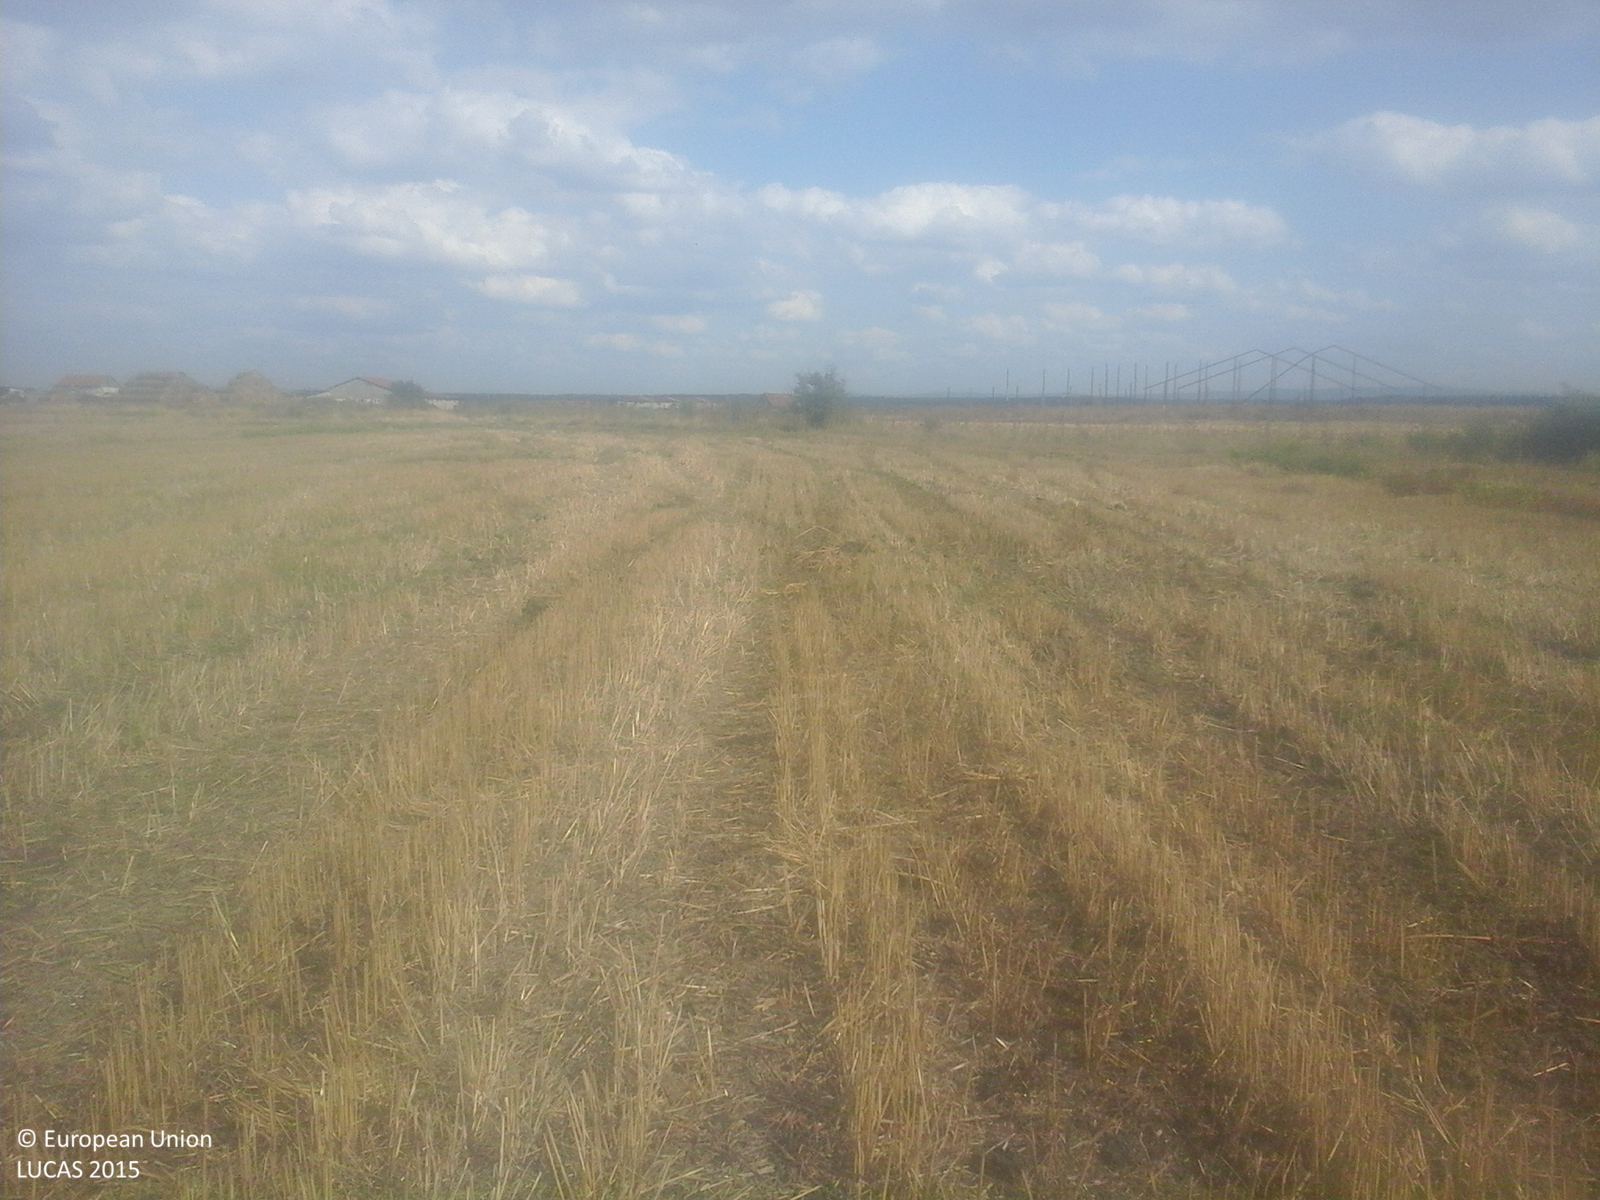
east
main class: Cropland
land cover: Common wheat
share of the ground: < 10 %
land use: Agriculture (excluding fallow land and kitchen gardens)
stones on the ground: < 10 %
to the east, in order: Common wheat; Tracks; Abandoned hedges; Ditches and canals; Grass margins; Maize; Tracks; Maize
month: September
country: RO
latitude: 47.6469
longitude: 22.7213
